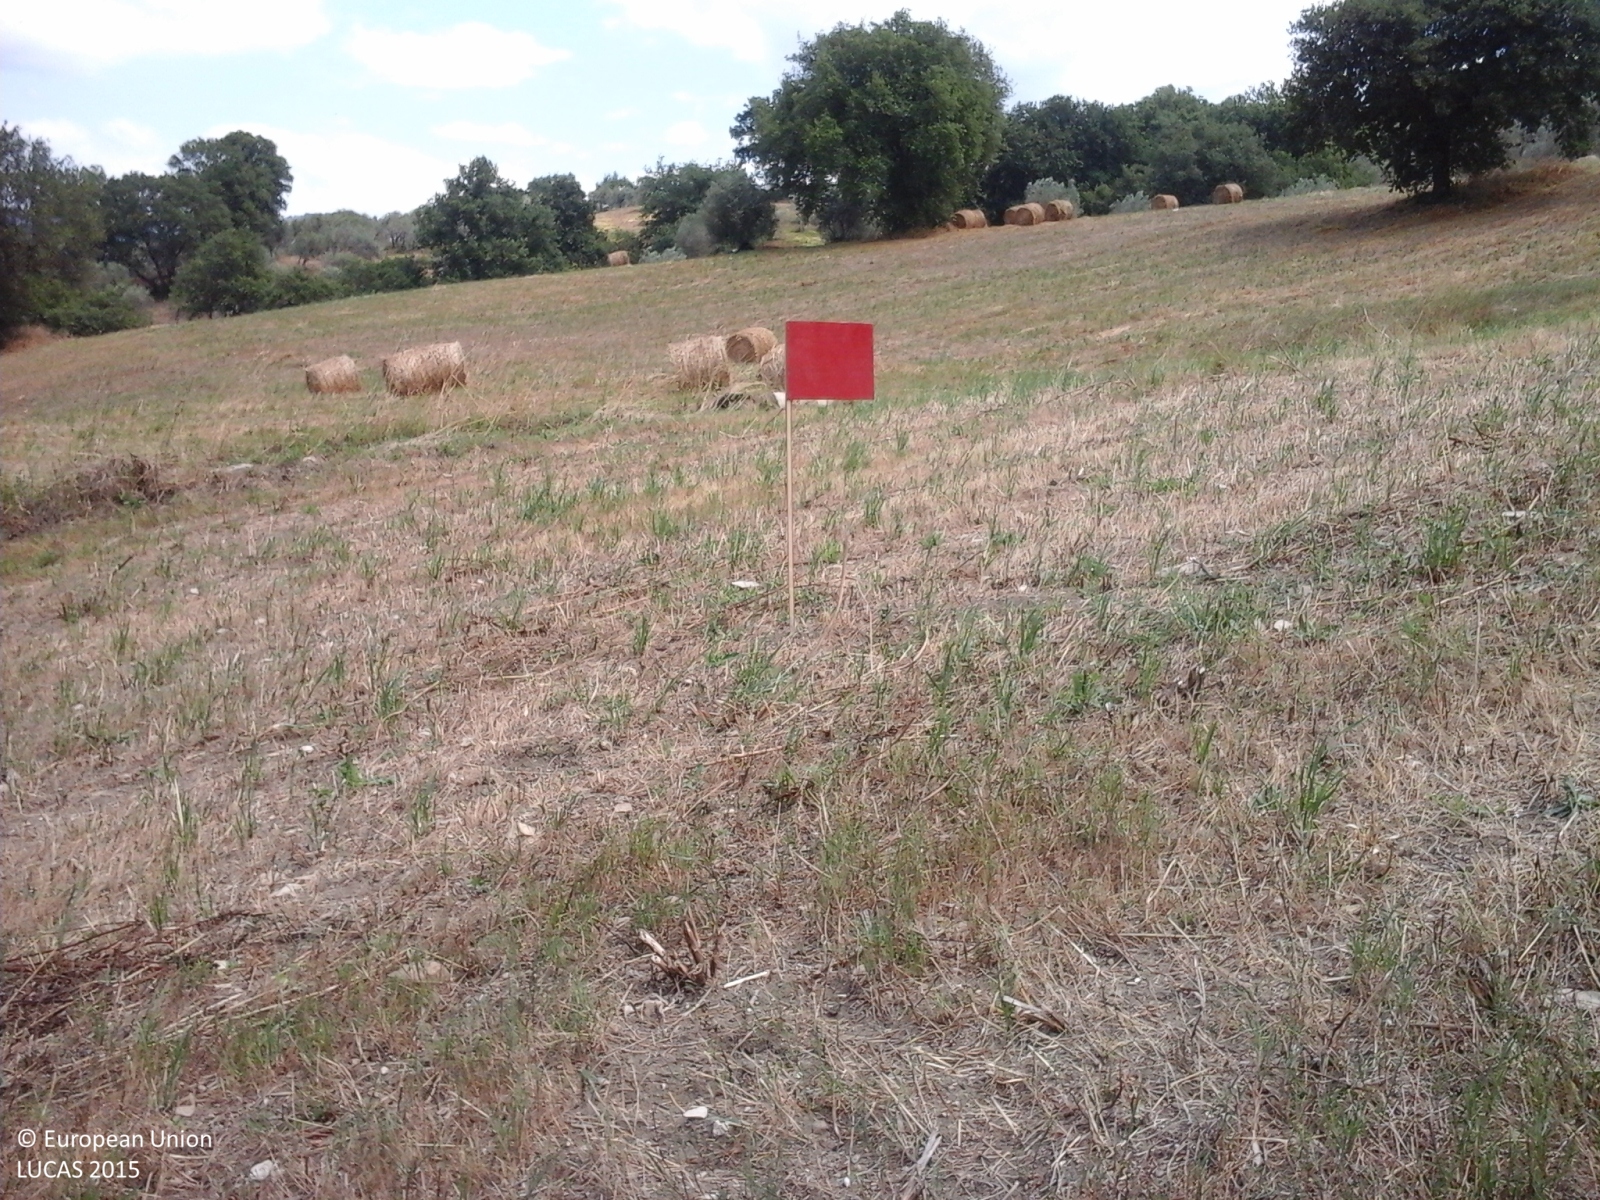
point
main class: Cropland
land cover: Temporary grasslands
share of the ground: > 75 %
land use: Agriculture (excluding fallow land and kitchen gardens)
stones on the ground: 10 - 25 %
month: June
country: IT
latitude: 40.4967
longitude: 15.1111
